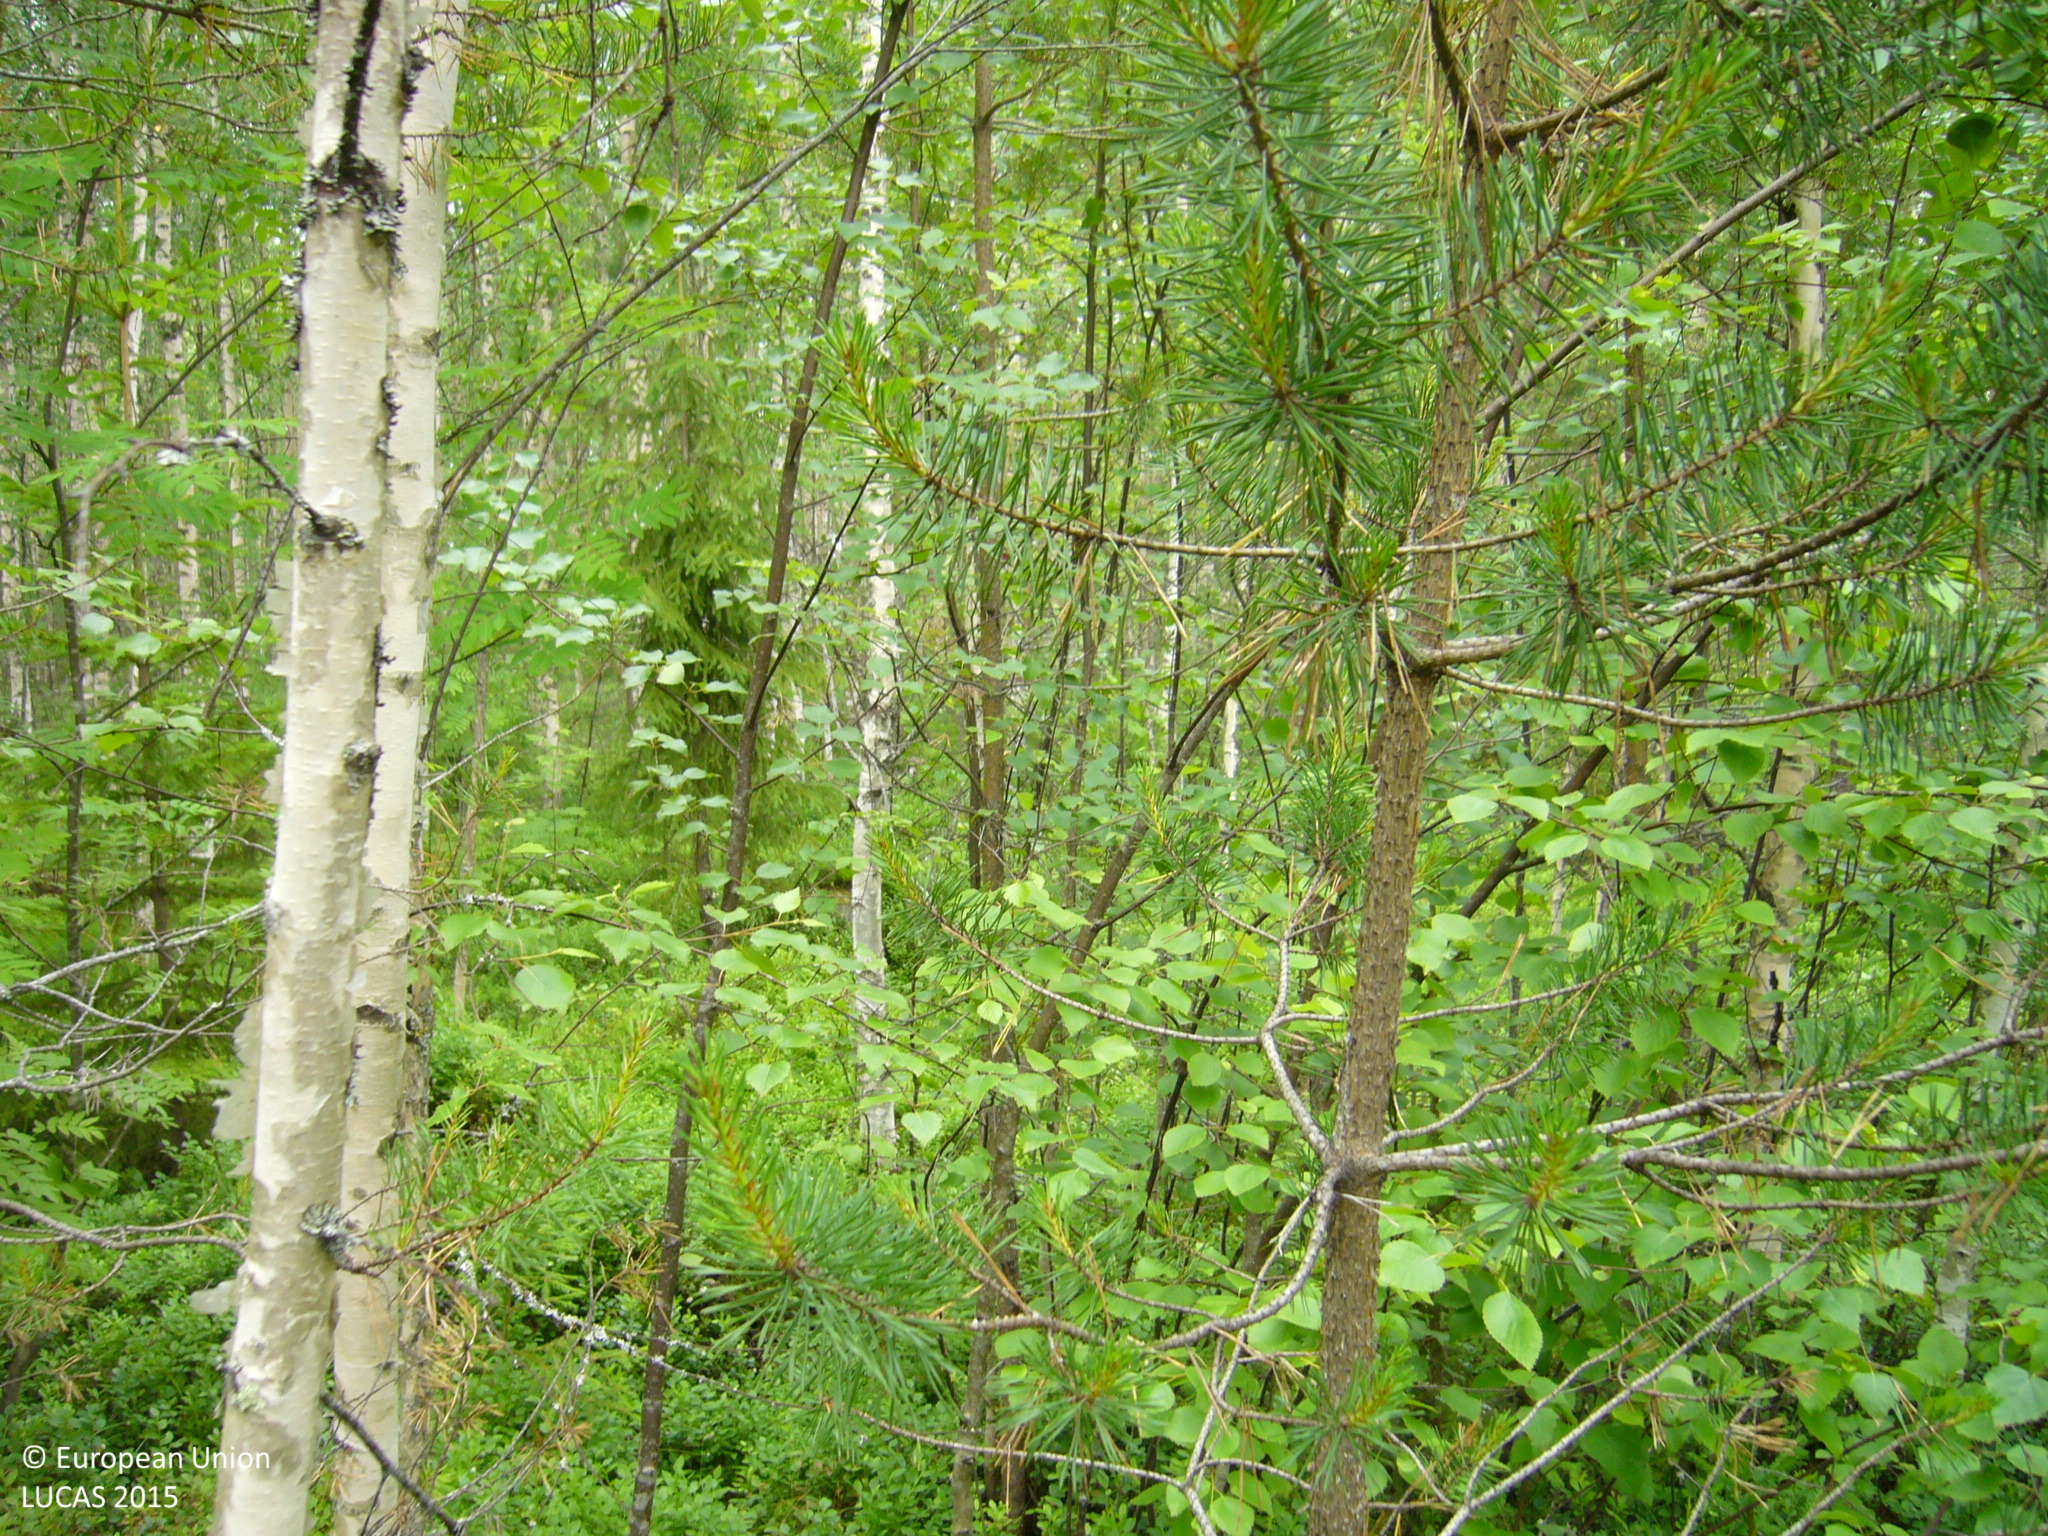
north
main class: Woodland
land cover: Pine dominated mixed woodland
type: boreal forest
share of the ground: > 75 %
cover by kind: coniferous forest trees 50 %, broadleaved forest trees 40 %, shrubs 10 %
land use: Forestry
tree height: > 5 m
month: July
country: FI
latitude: 63.1872
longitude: 26.1977
